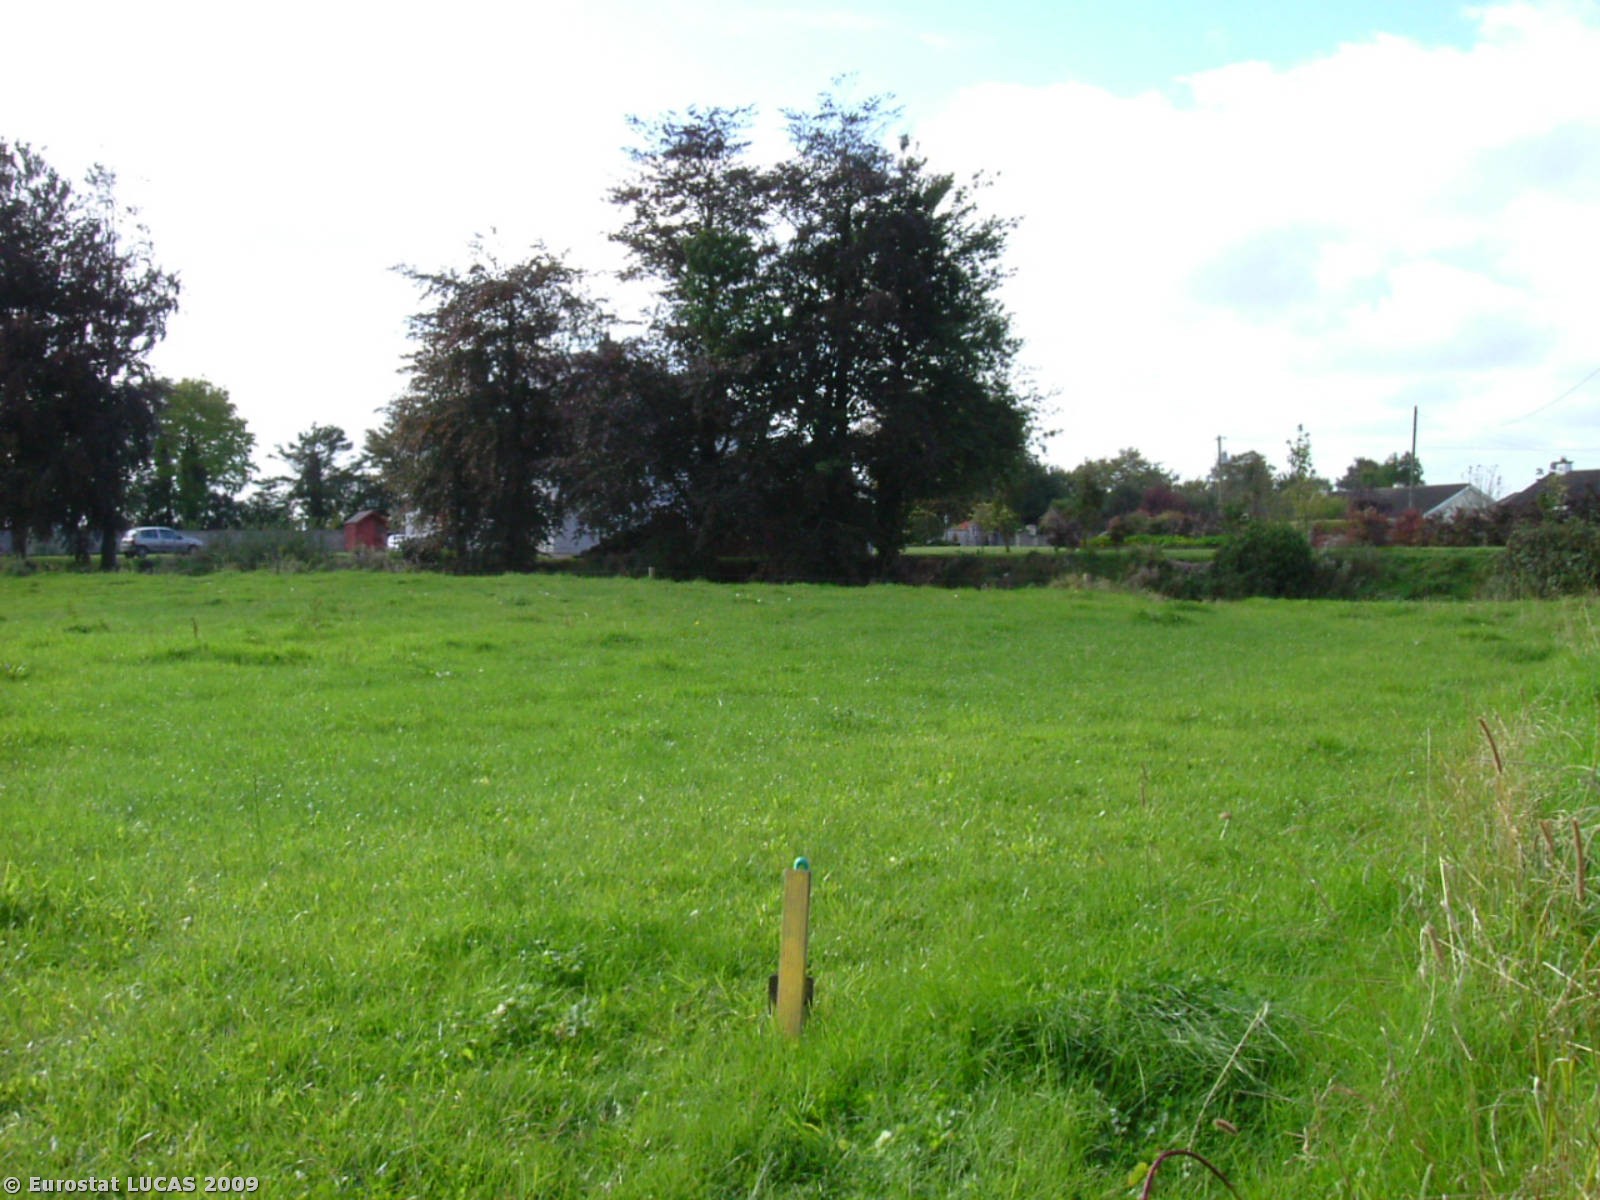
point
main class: Grassland
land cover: Grassland without tree/shrub cover
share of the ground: > 75 %
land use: Agriculture (excluding fallow land and kitchen gardens)
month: September
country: IE
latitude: 52.8038
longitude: -7.8060
